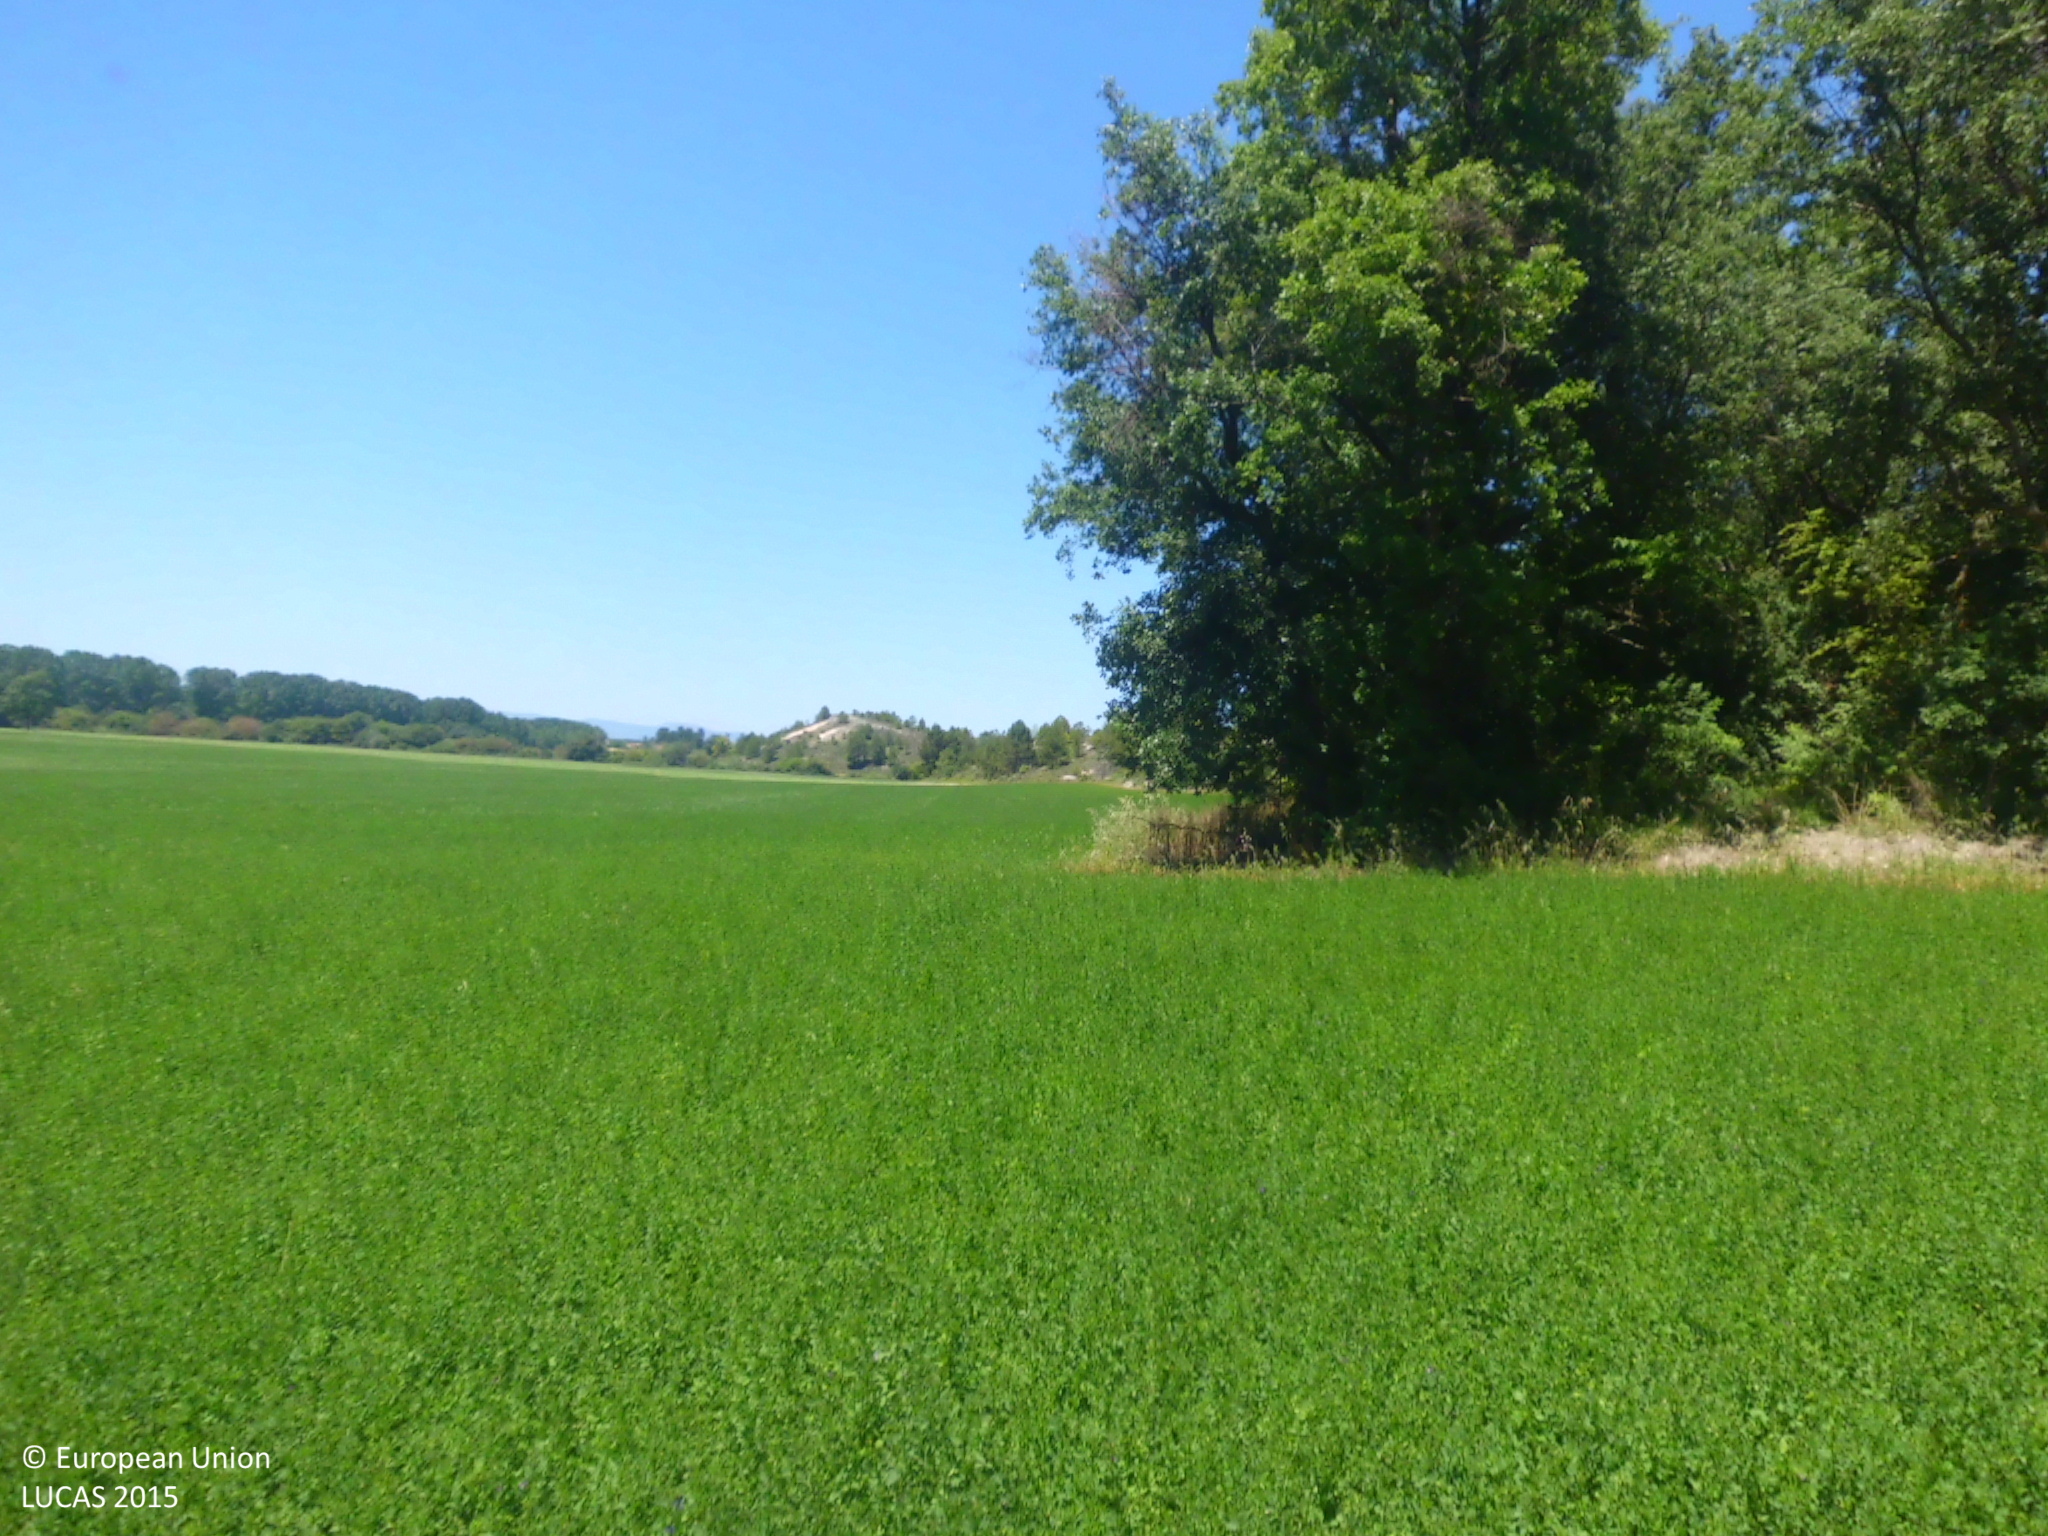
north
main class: Cropland
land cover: Lucerne
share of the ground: > 75 %
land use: Agriculture (excluding fallow land and kitchen gardens)
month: June
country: ES
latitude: 42.8186
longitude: -3.4050
